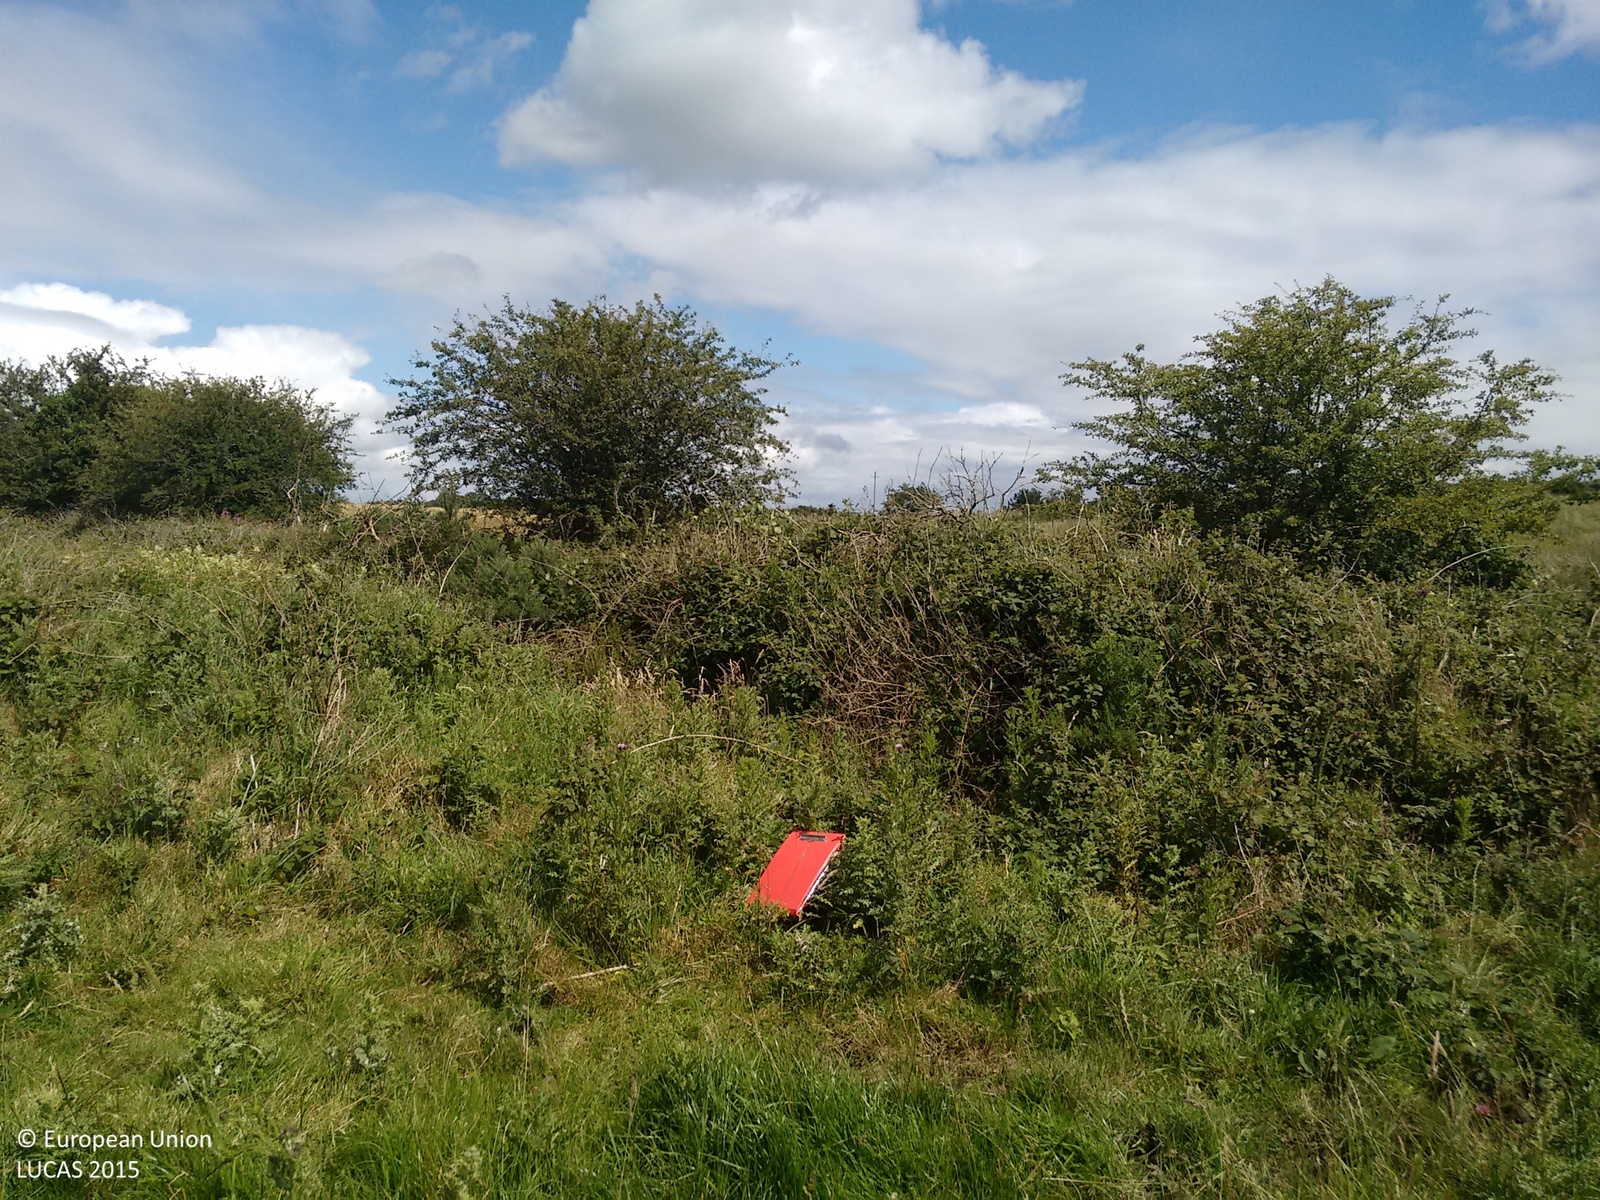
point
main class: Grassland
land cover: Grassland with sparse tree/shrub cover
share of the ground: 50 - 75 %
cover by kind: herbaceous plants 85 %, shrubs 10 %, broadleaved forest trees 5 %
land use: Agriculture (excluding fallow land and kitchen gardens)
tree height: < 5 m
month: July
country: IE
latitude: 53.6925
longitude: -8.7541
